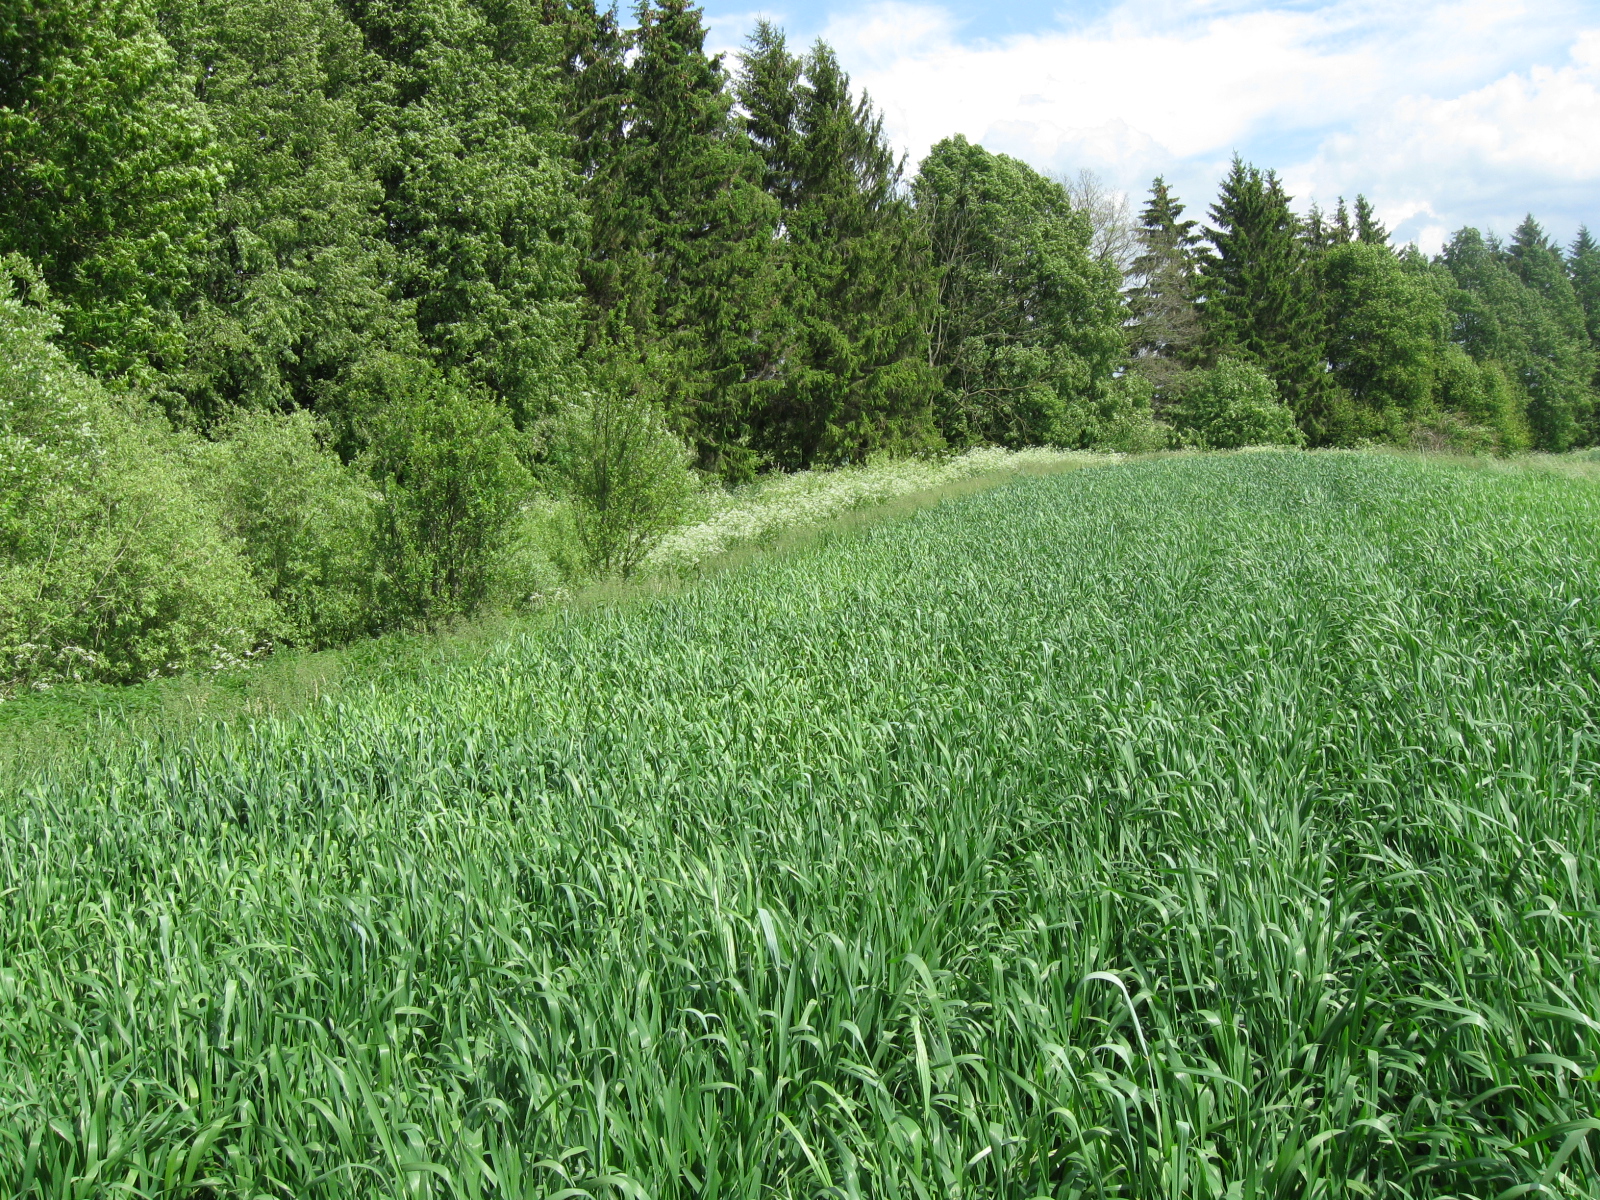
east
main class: Cropland
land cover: Common wheat
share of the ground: > 75 %
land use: Agriculture (excluding fallow land and kitchen gardens)
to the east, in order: Common wheat; Spontaneously vegetated surfaces; Broadleaved woodland; Rivers and streams; Broadleaved woodland; Spruce dominated mixed woodland; Tracks; Grassland without tree/shrub cover; Spruce dominated mixed woodland; Tracks; Grassland without tree/shrub cover
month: June
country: LT
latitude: 54.3419
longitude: 23.7935
